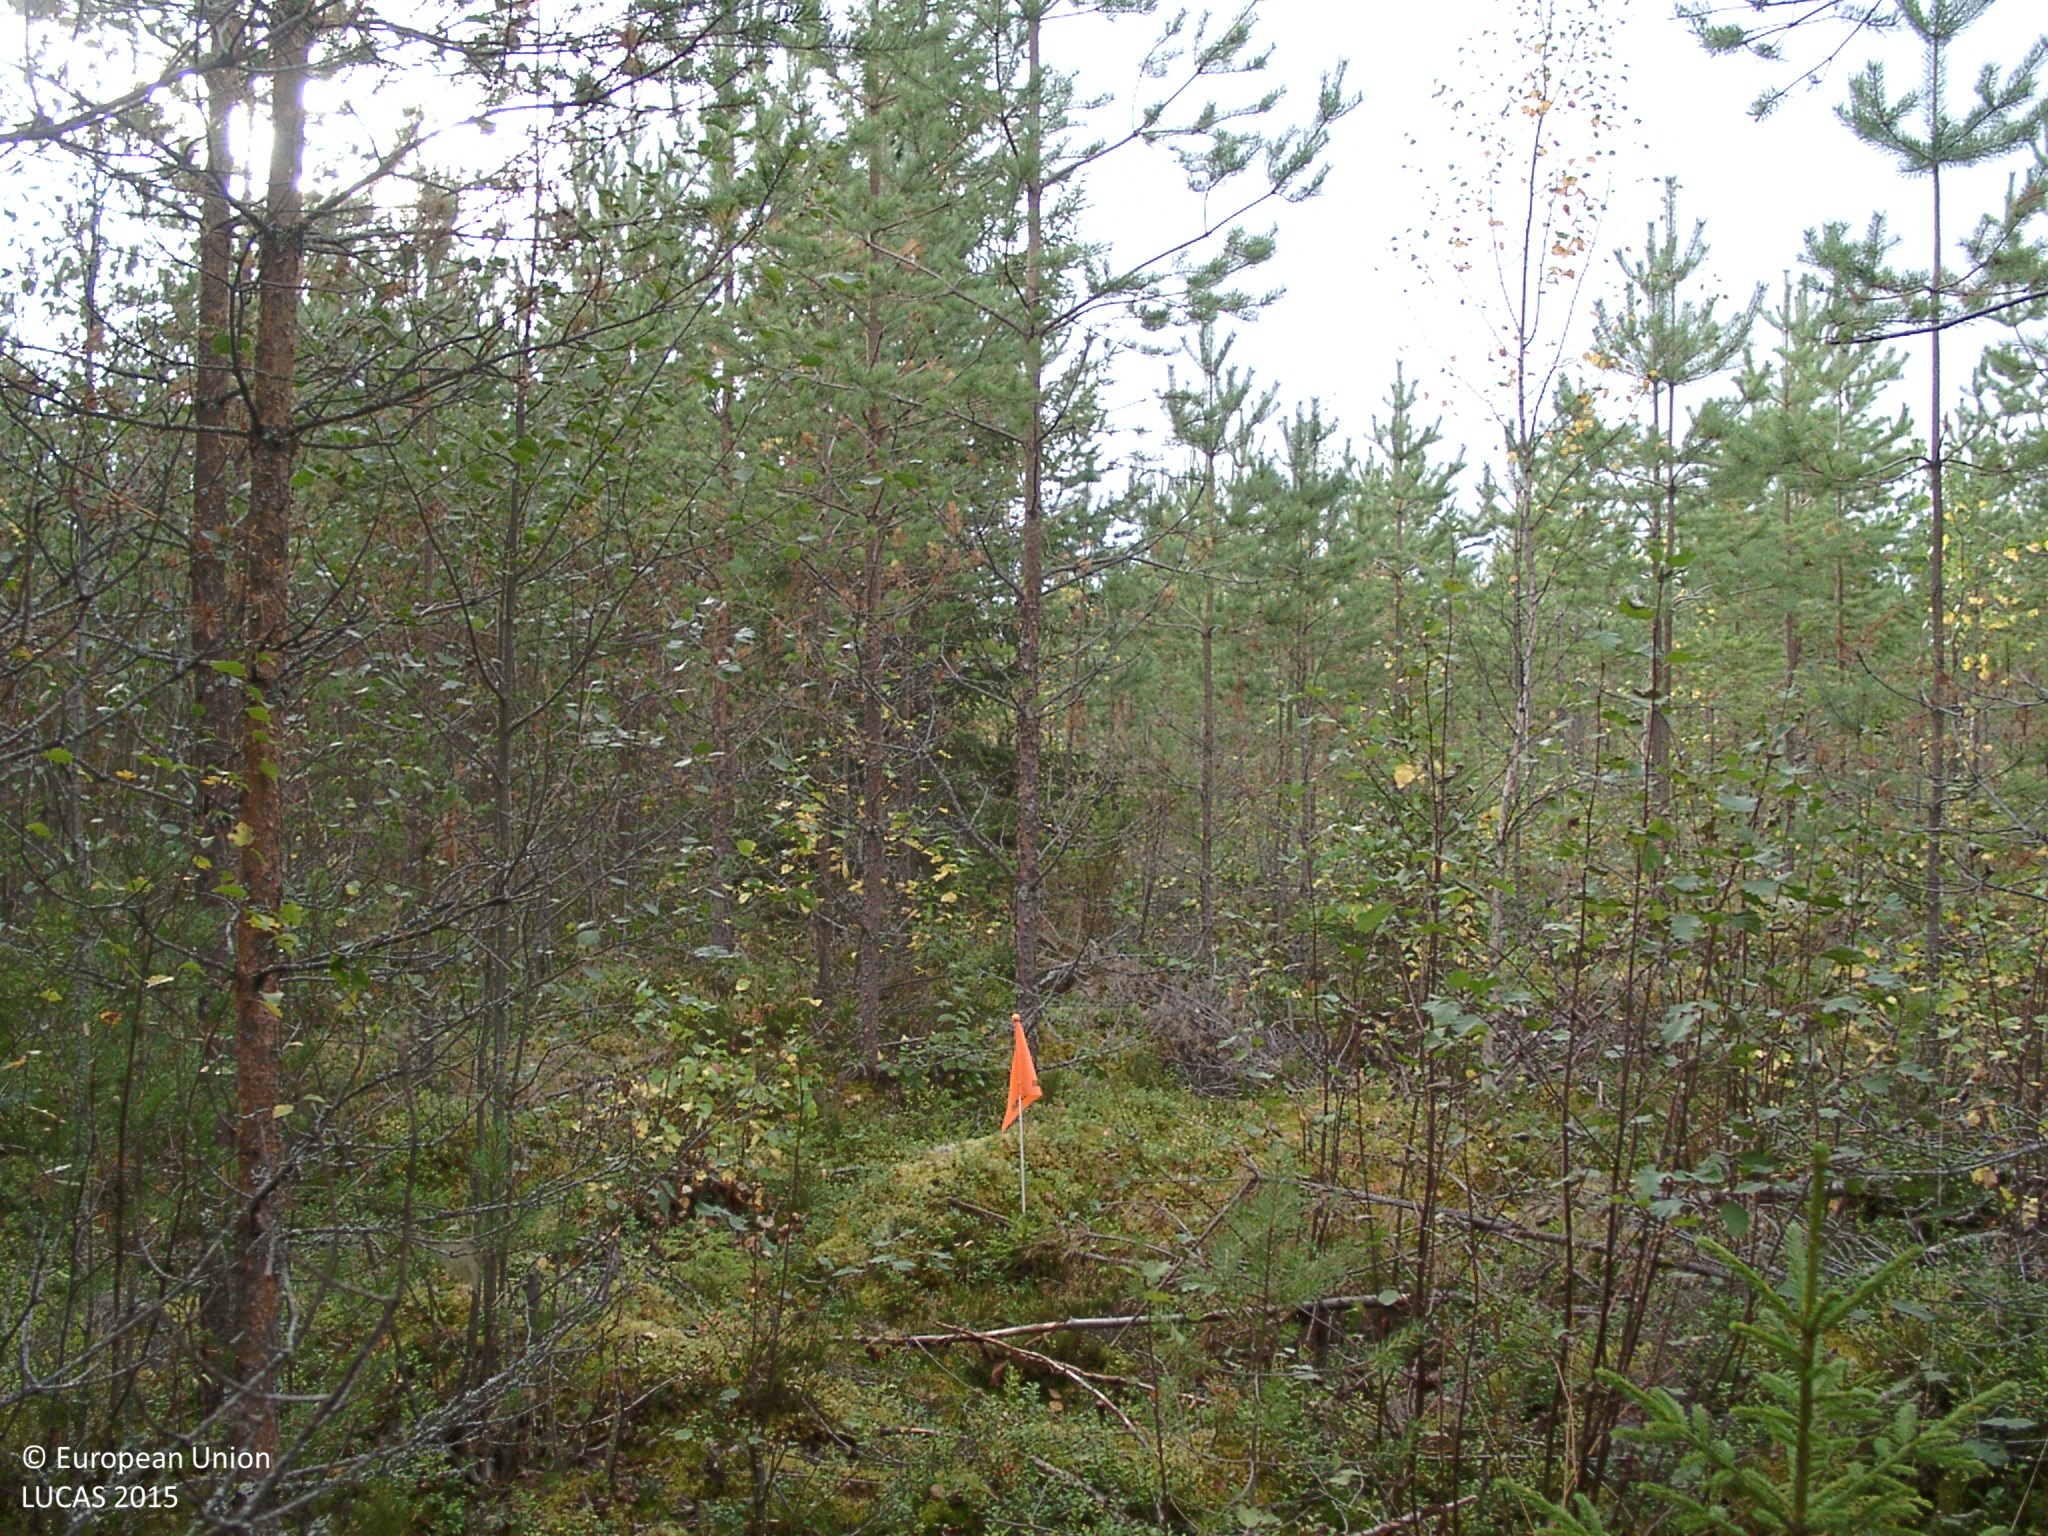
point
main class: Woodland
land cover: Pine dominated mixed woodland
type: boreal forest
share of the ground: 50 - 75 %
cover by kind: coniferous forest trees 45 %, shrubs 20 %, lichens and mosses 20 %, broadleaved forest trees 15 %
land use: Forestry
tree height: < 5 m
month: September
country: FI
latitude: 62.6759
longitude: 25.4377
